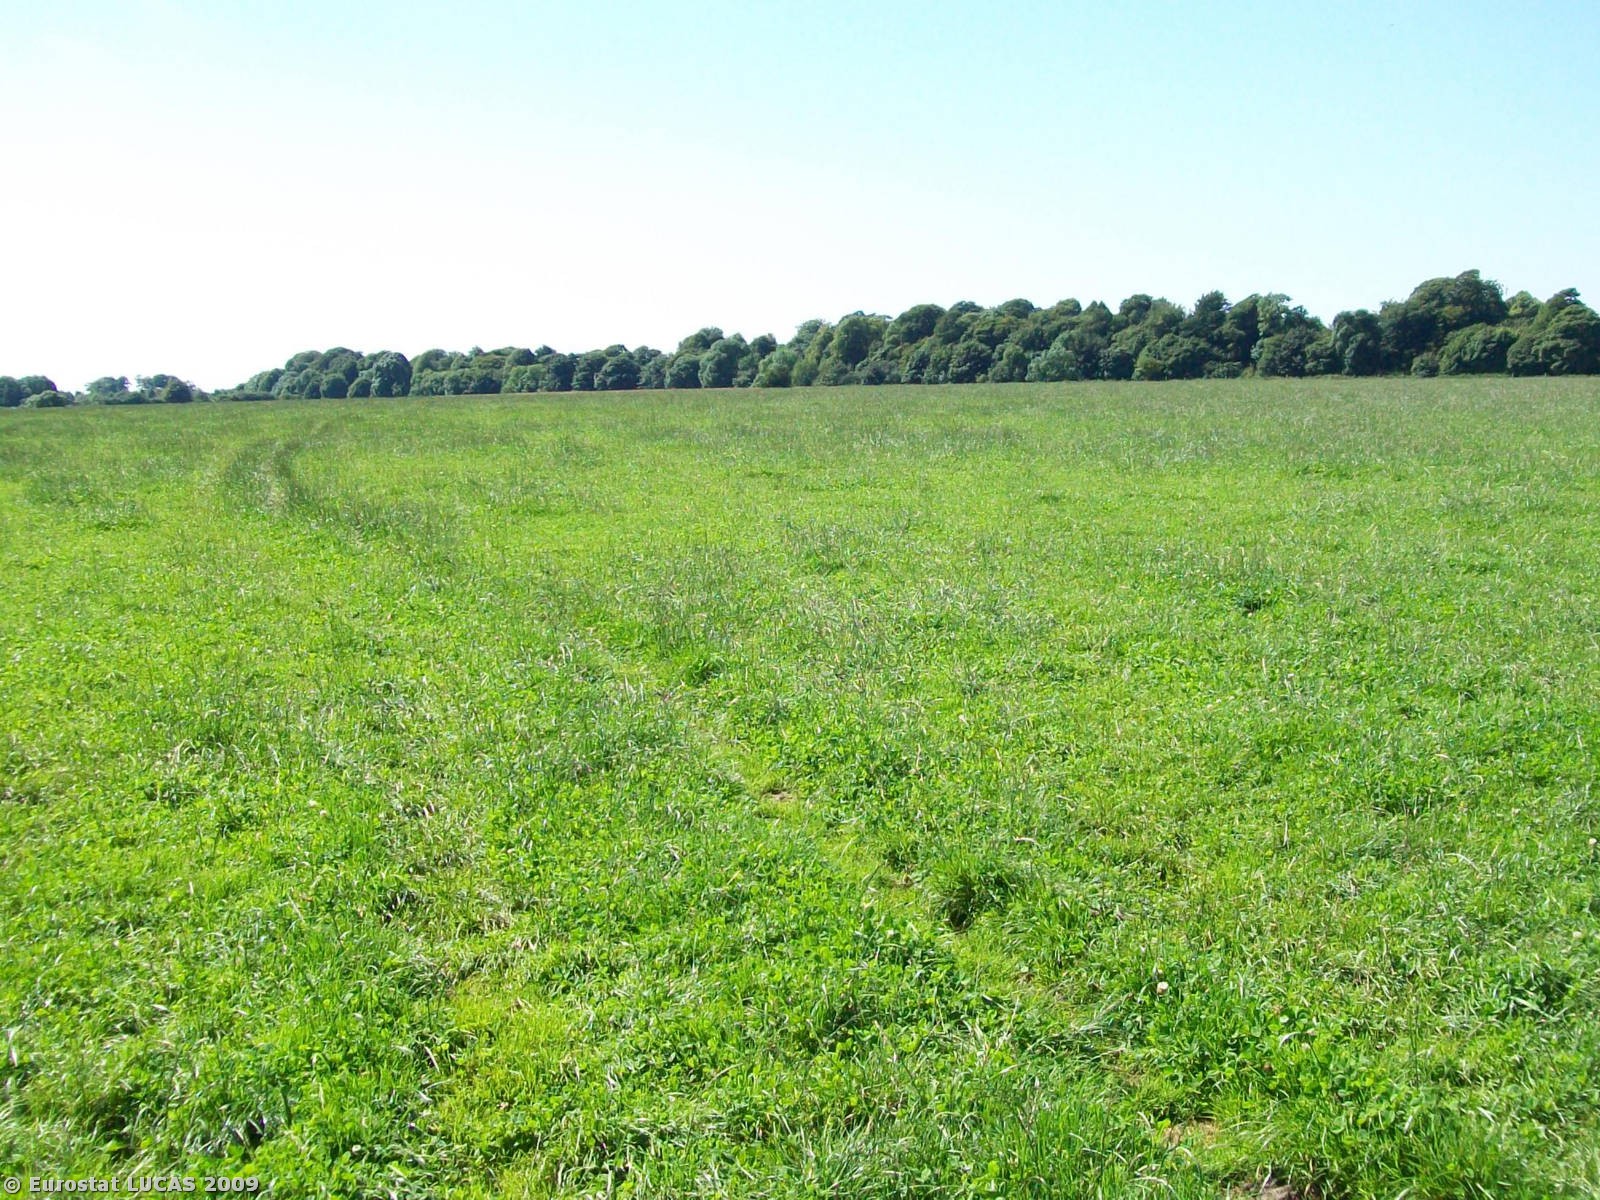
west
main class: Grassland
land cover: Grassland without tree/shrub cover
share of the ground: > 75 %
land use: Agriculture (excluding fallow land and kitchen gardens)
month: August
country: GB
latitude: 51.6612
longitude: -2.3081
